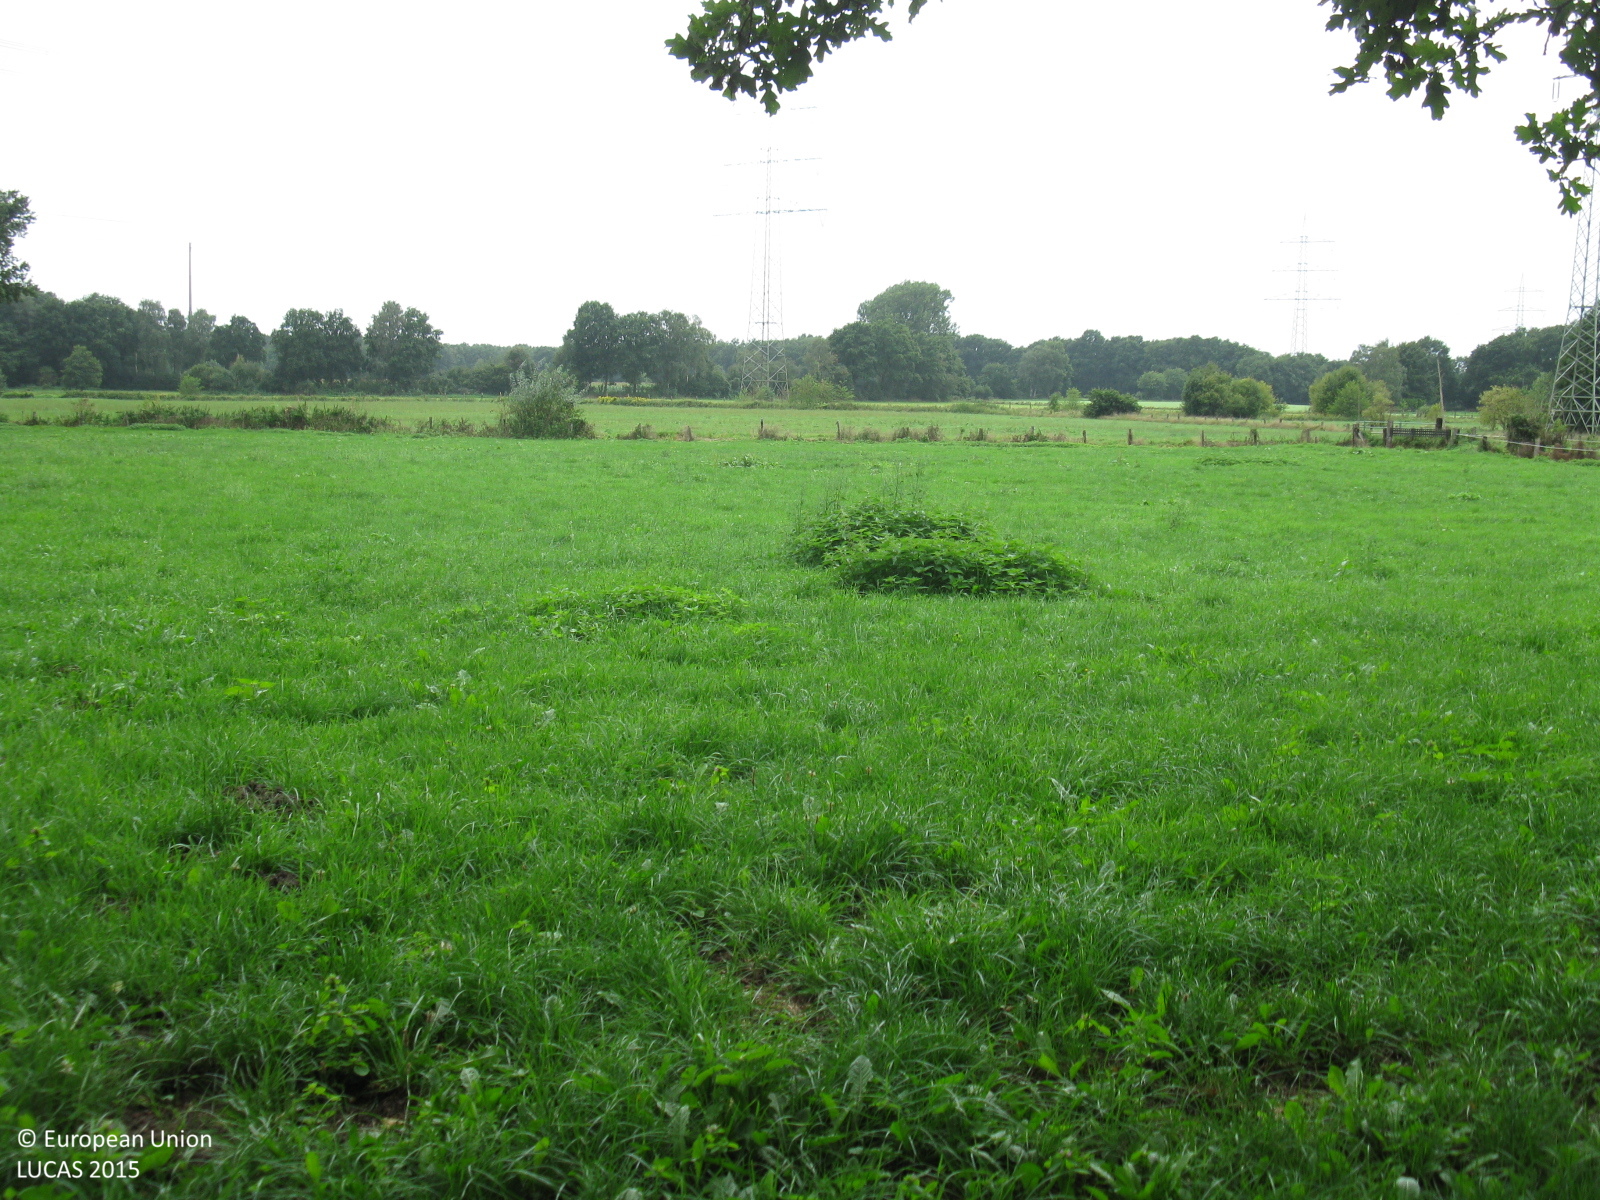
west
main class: Grassland
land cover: Grassland without tree/shrub cover
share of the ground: > 75 %
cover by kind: herbaceous plants 100 %
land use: Agriculture (excluding fallow land and kitchen gardens)
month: August
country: DE
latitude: 51.7101
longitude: 7.0043
